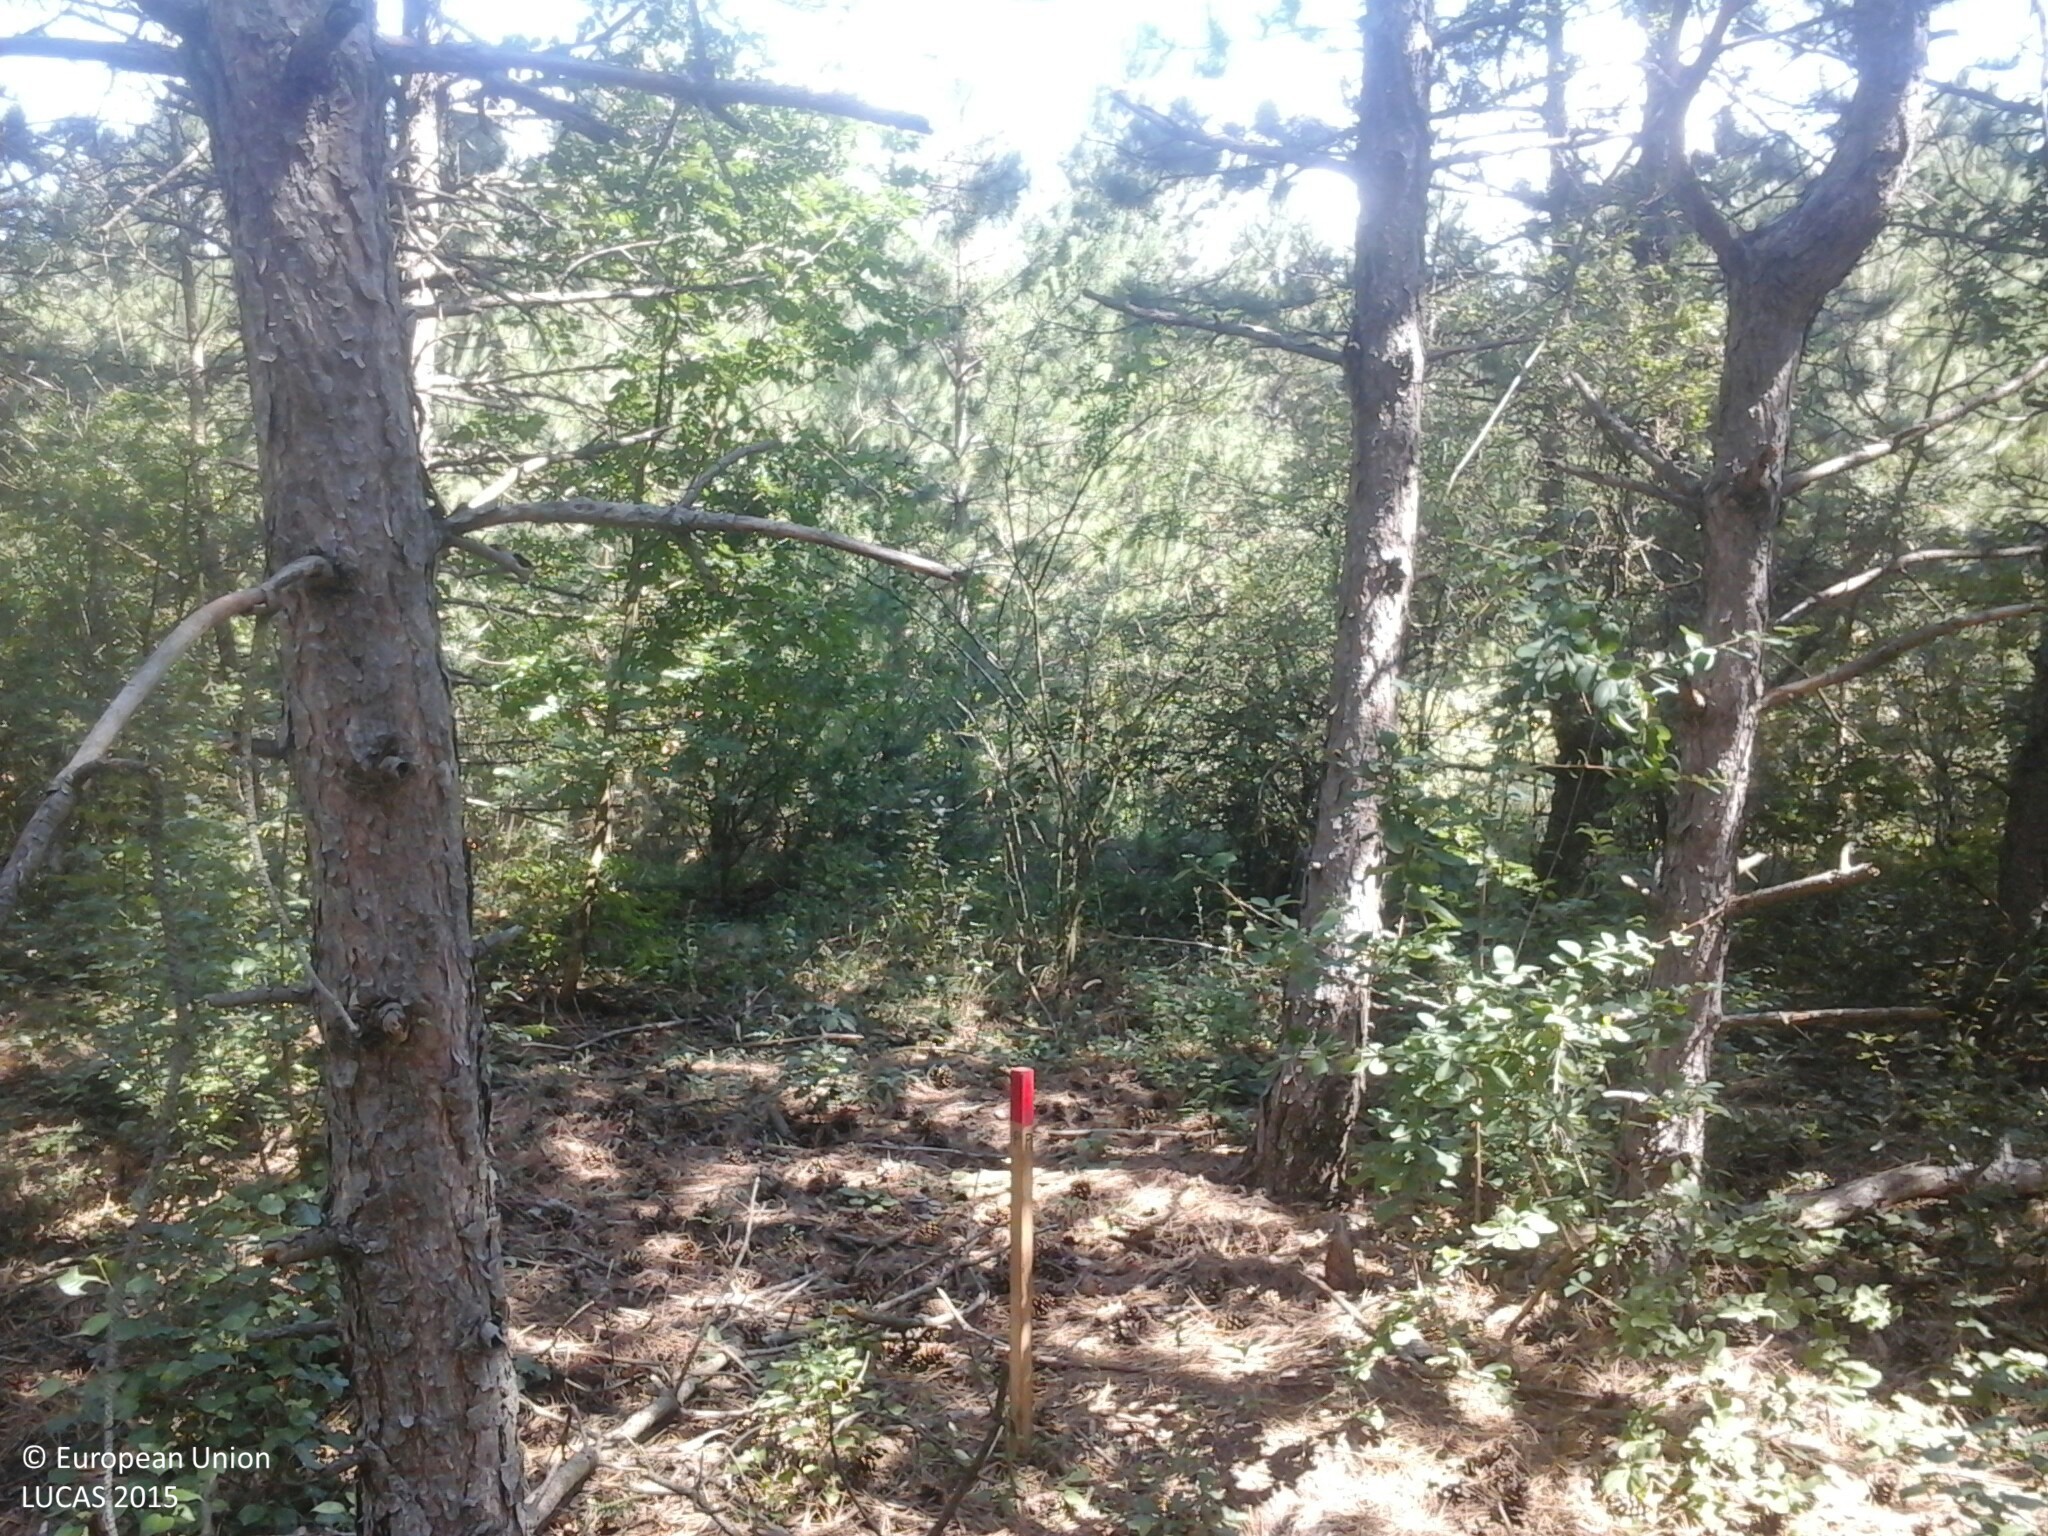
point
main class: Woodland
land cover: Other coniferous woodland
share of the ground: > 75 %
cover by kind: coniferous forest trees 70 %, shrubs 20 %, herbaceous plants 10 %
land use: Forestry
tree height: < 5 m
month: July
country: HU
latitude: 47.2154
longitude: 18.1577
